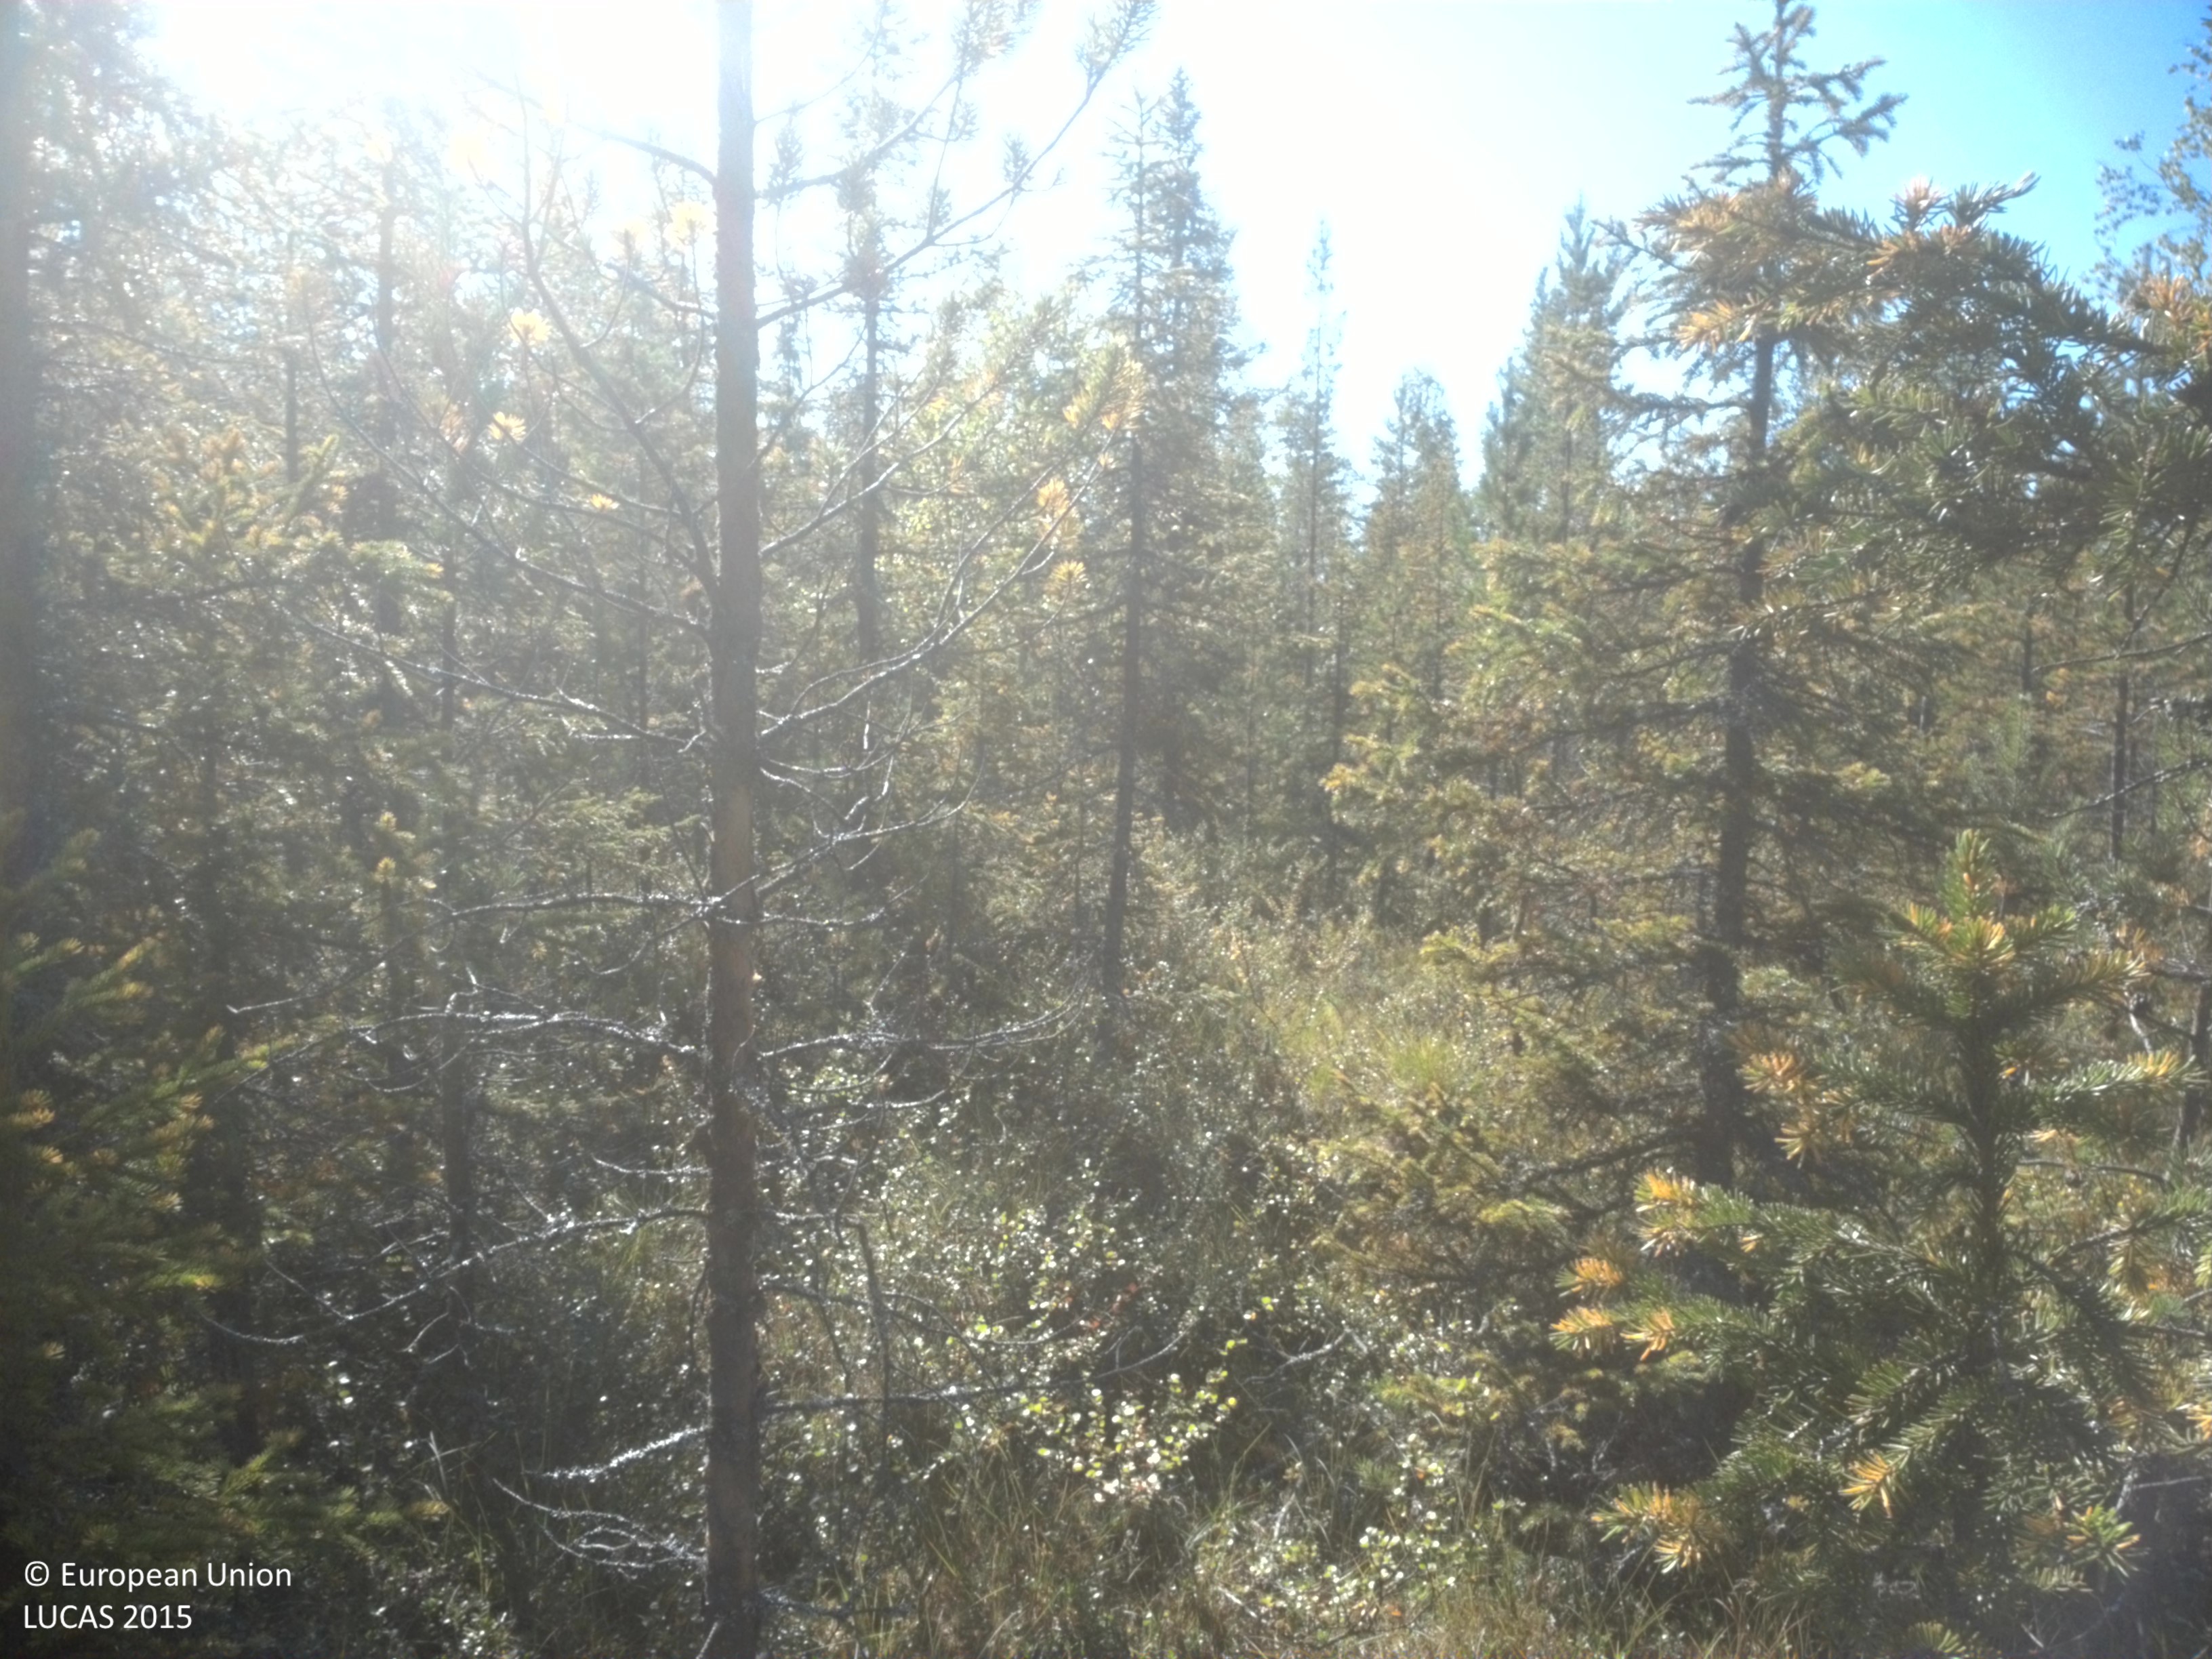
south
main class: Woodland
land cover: Pine dominated coniferous woodland
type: boreal forest
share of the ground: 50 - 75 %
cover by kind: coniferous forest trees 60 %, shrubs 20 %, herbaceous plants 10 %, lichens and mosses 10 %
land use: Forestry
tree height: > 5 m
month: August
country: SE
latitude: 64.6950
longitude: 18.8791
